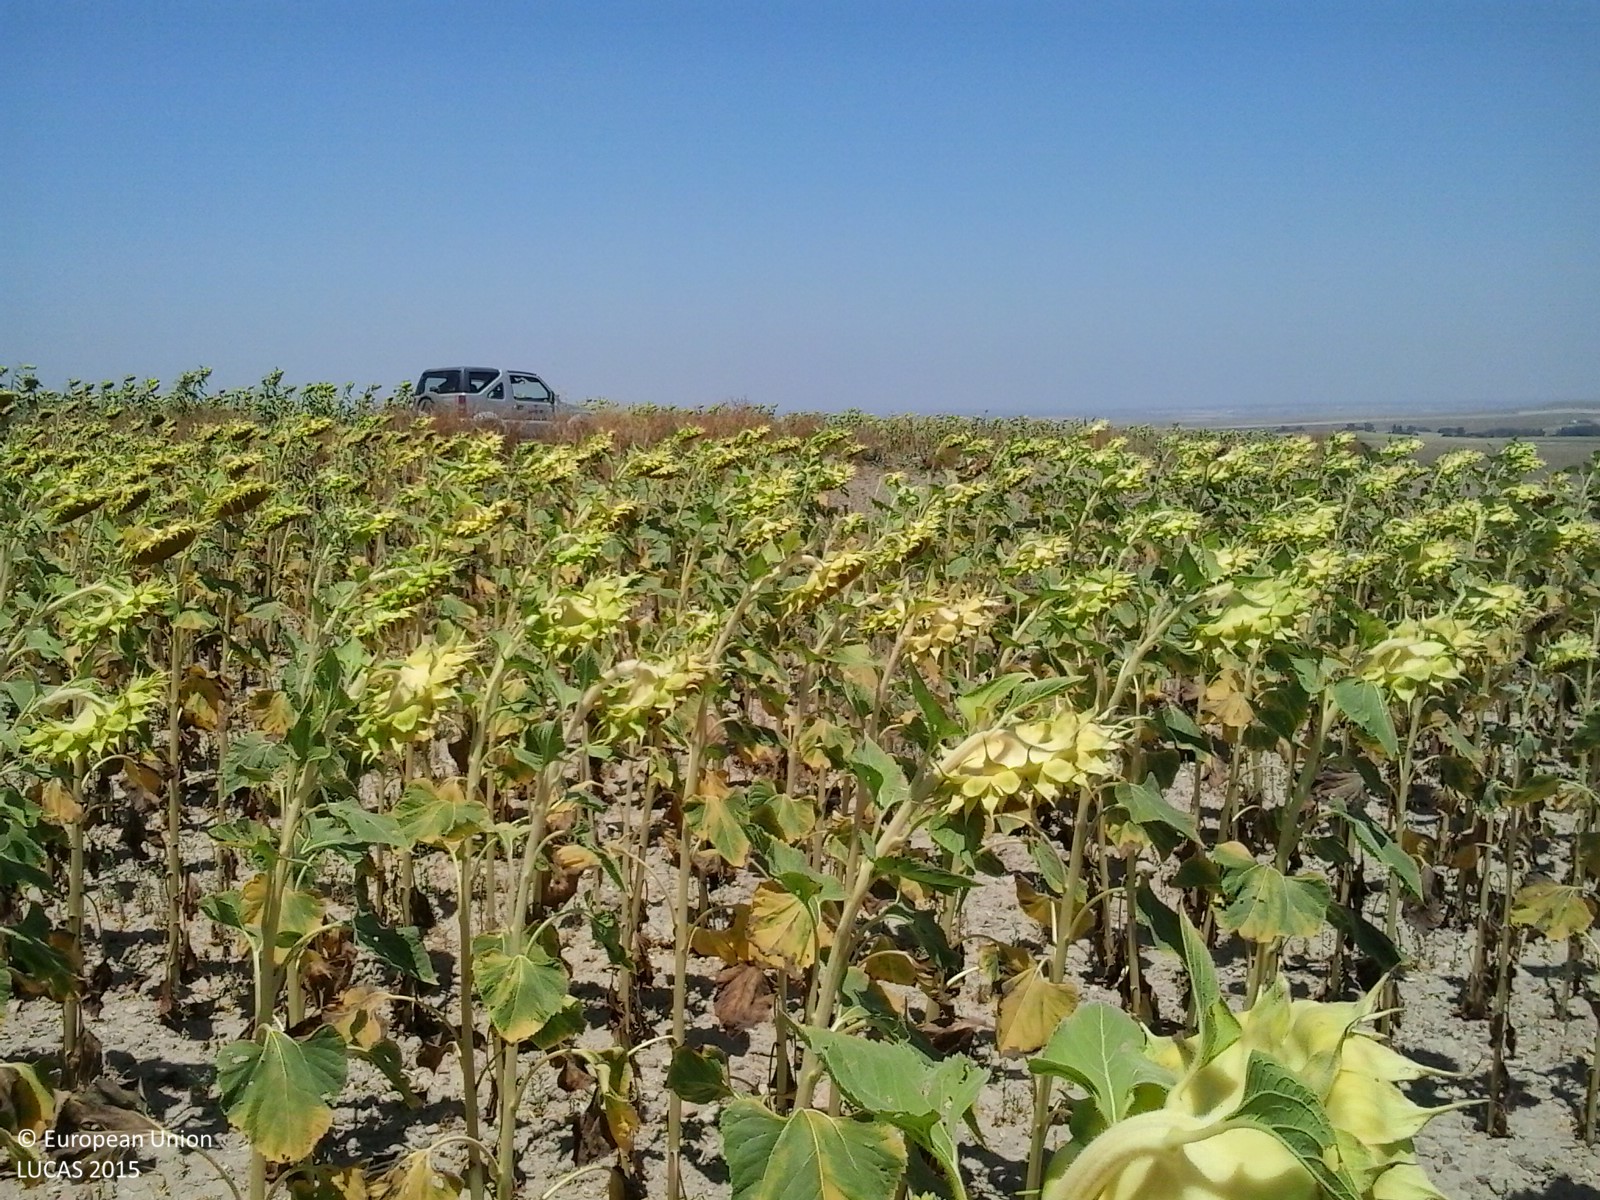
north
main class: Cropland
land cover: Sunflower
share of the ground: 50 - 75 %
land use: Agriculture (excluding fallow land and kitchen gardens)
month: June
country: ES
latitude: 37.3997
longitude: -6.3074
